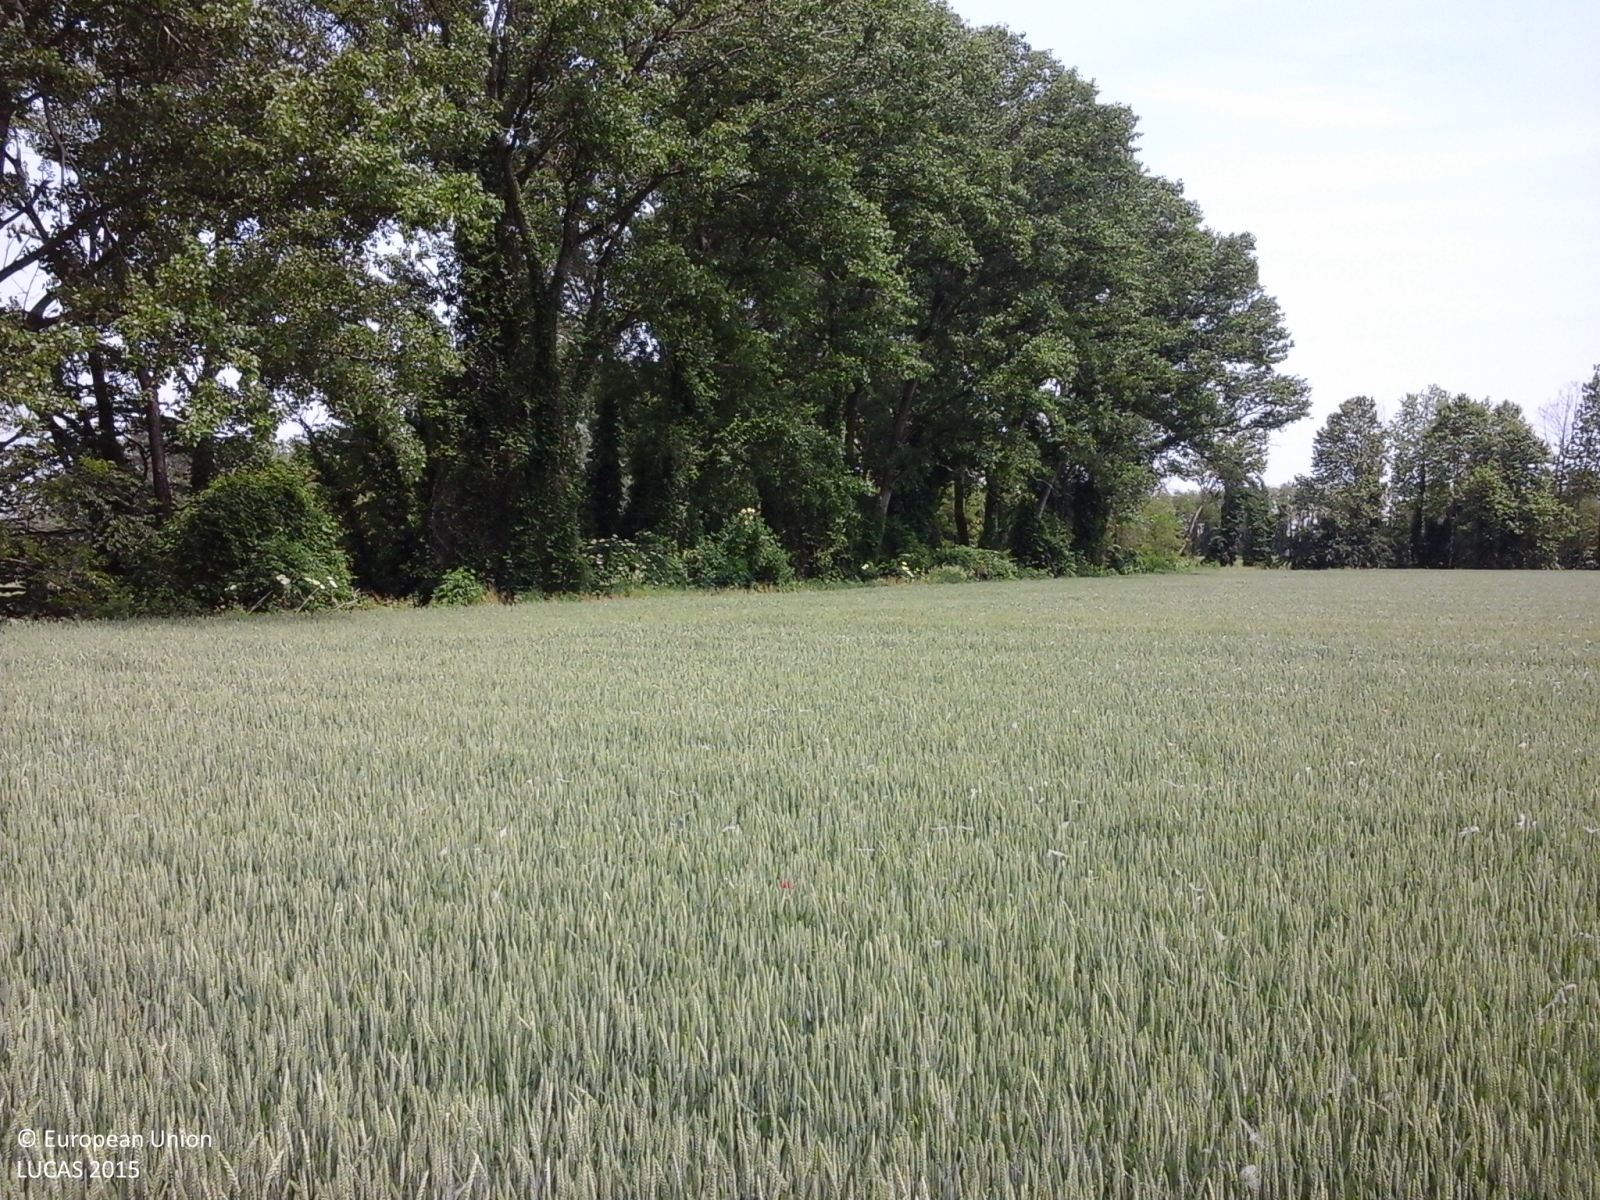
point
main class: Cropland
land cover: Common wheat
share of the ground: > 75 %
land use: Agriculture (excluding fallow land and kitchen gardens)
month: May
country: IT
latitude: 45.3061
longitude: 9.9618
